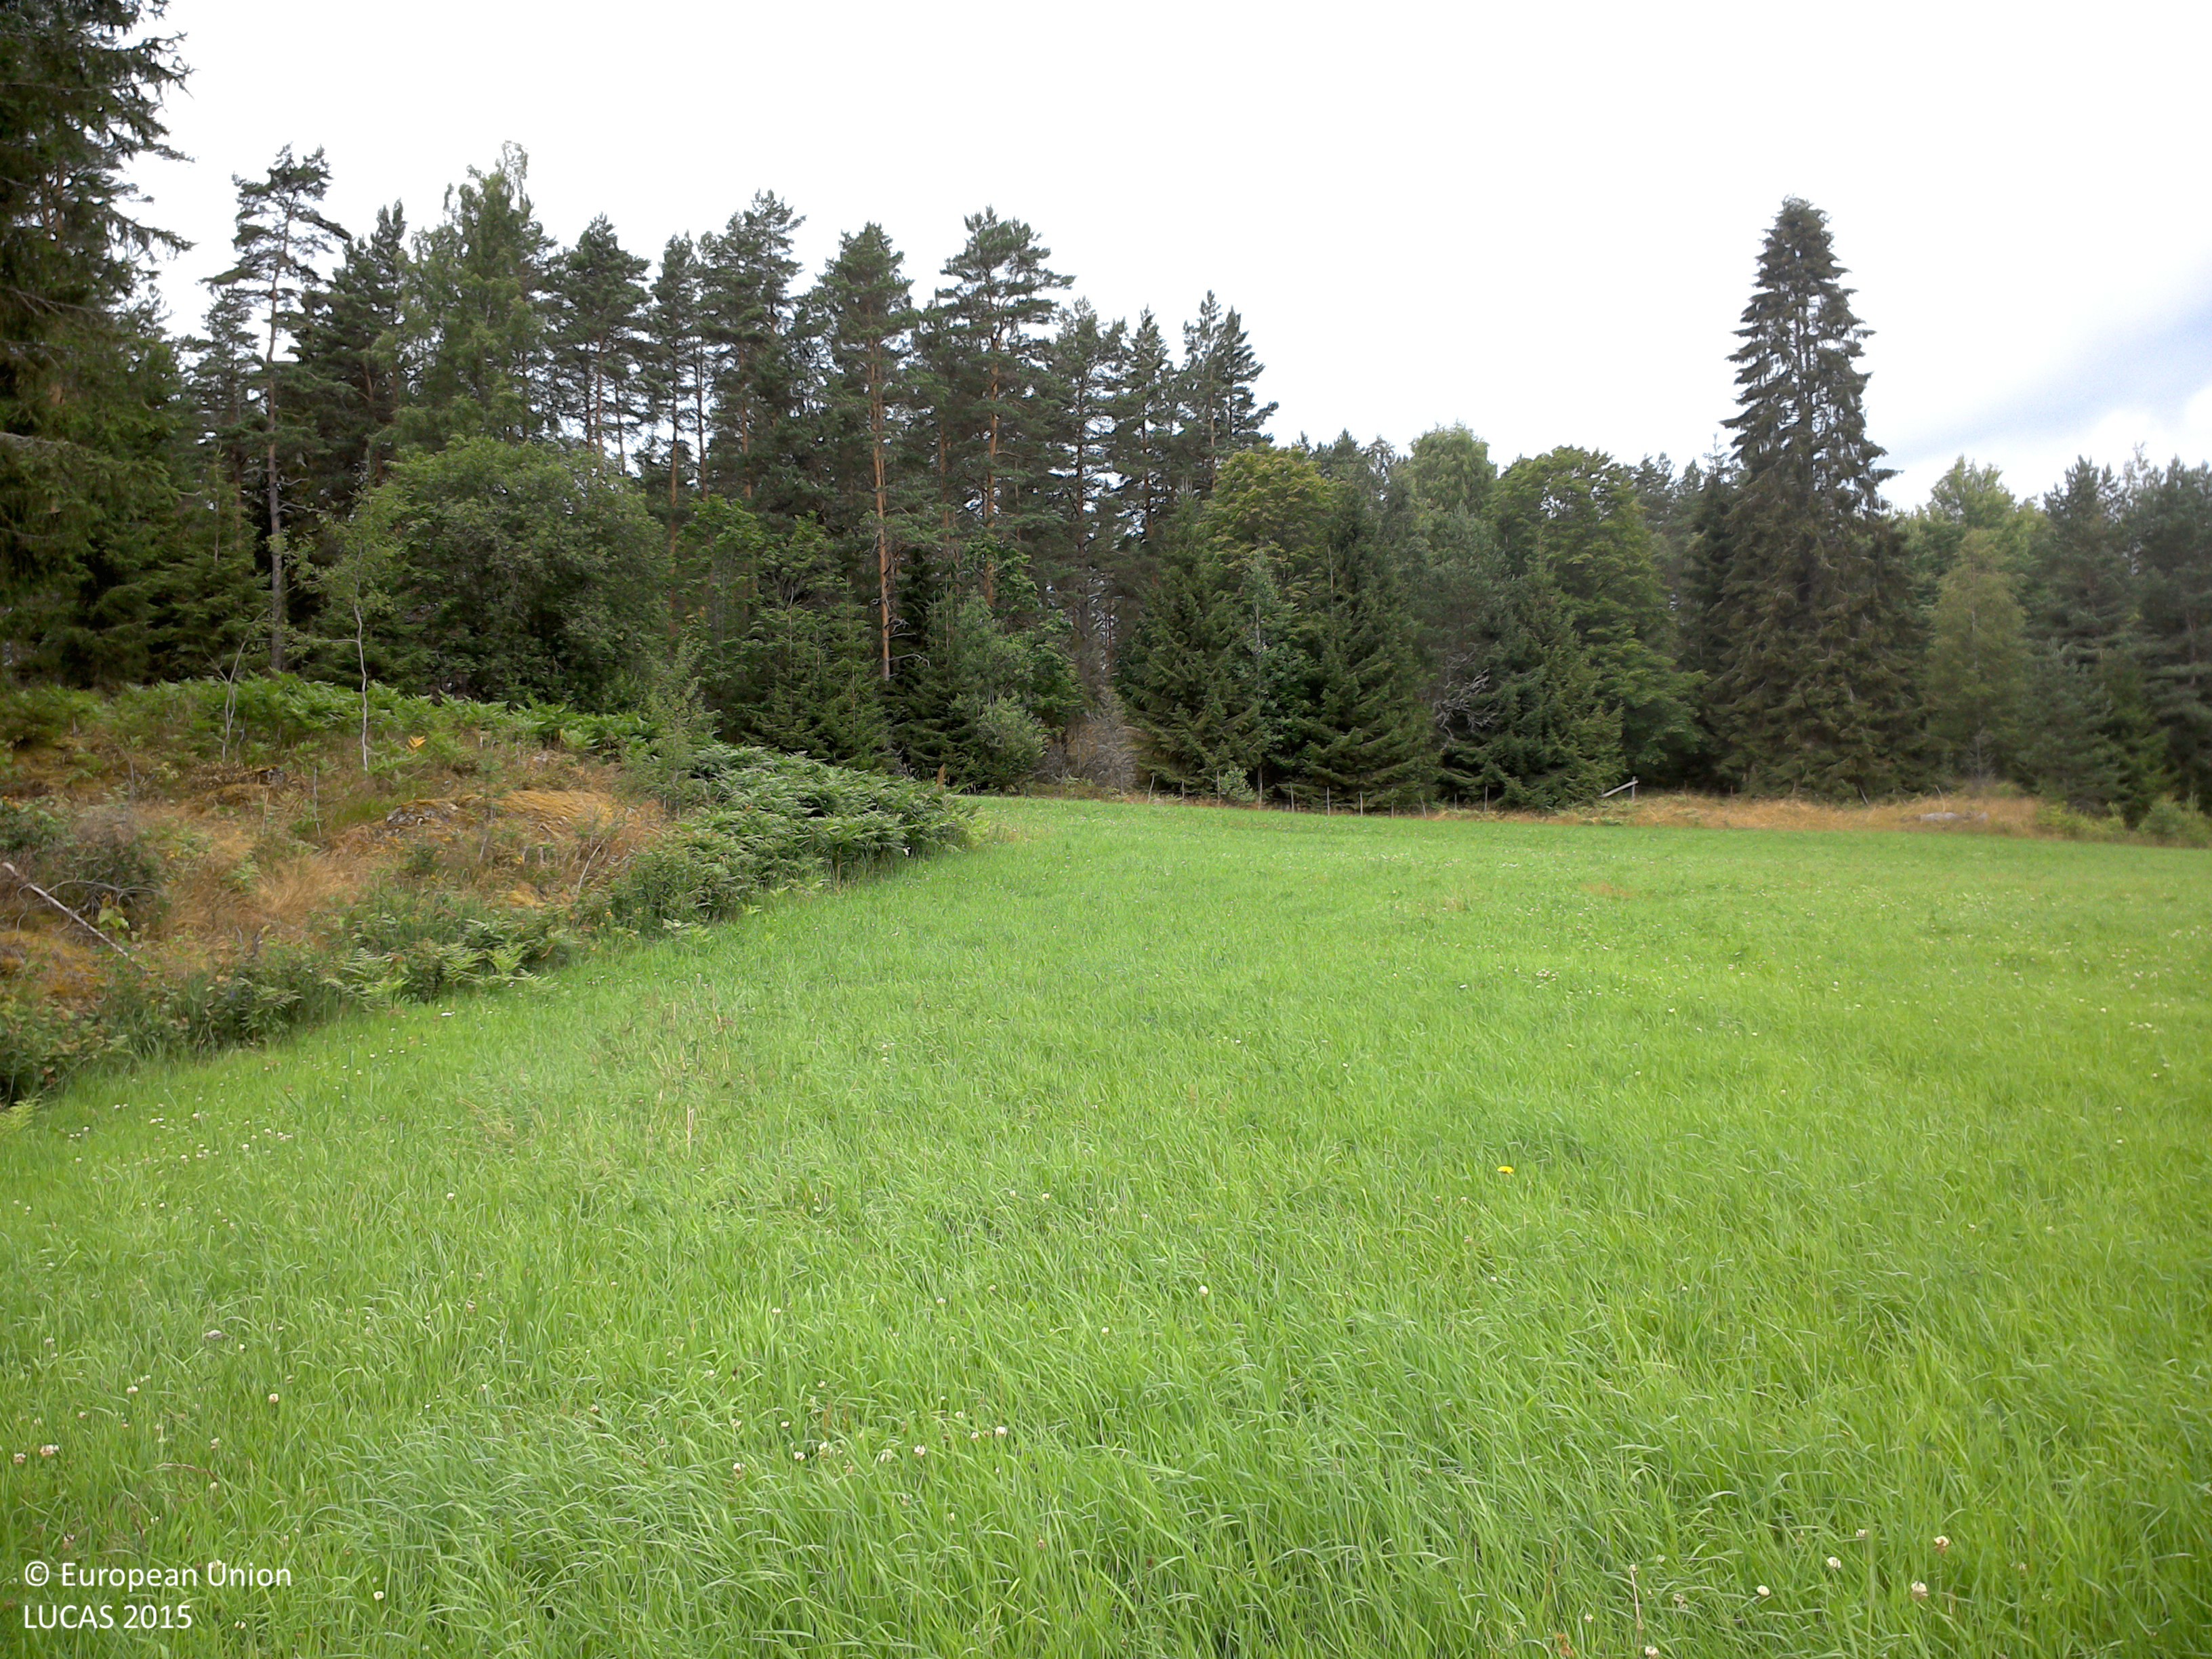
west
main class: Cropland
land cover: Other leguminous and mixtures for fodder
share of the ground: > 75 %
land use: Agriculture (excluding fallow land and kitchen gardens)
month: July
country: SE
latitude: 57.7430
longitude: 15.9944
